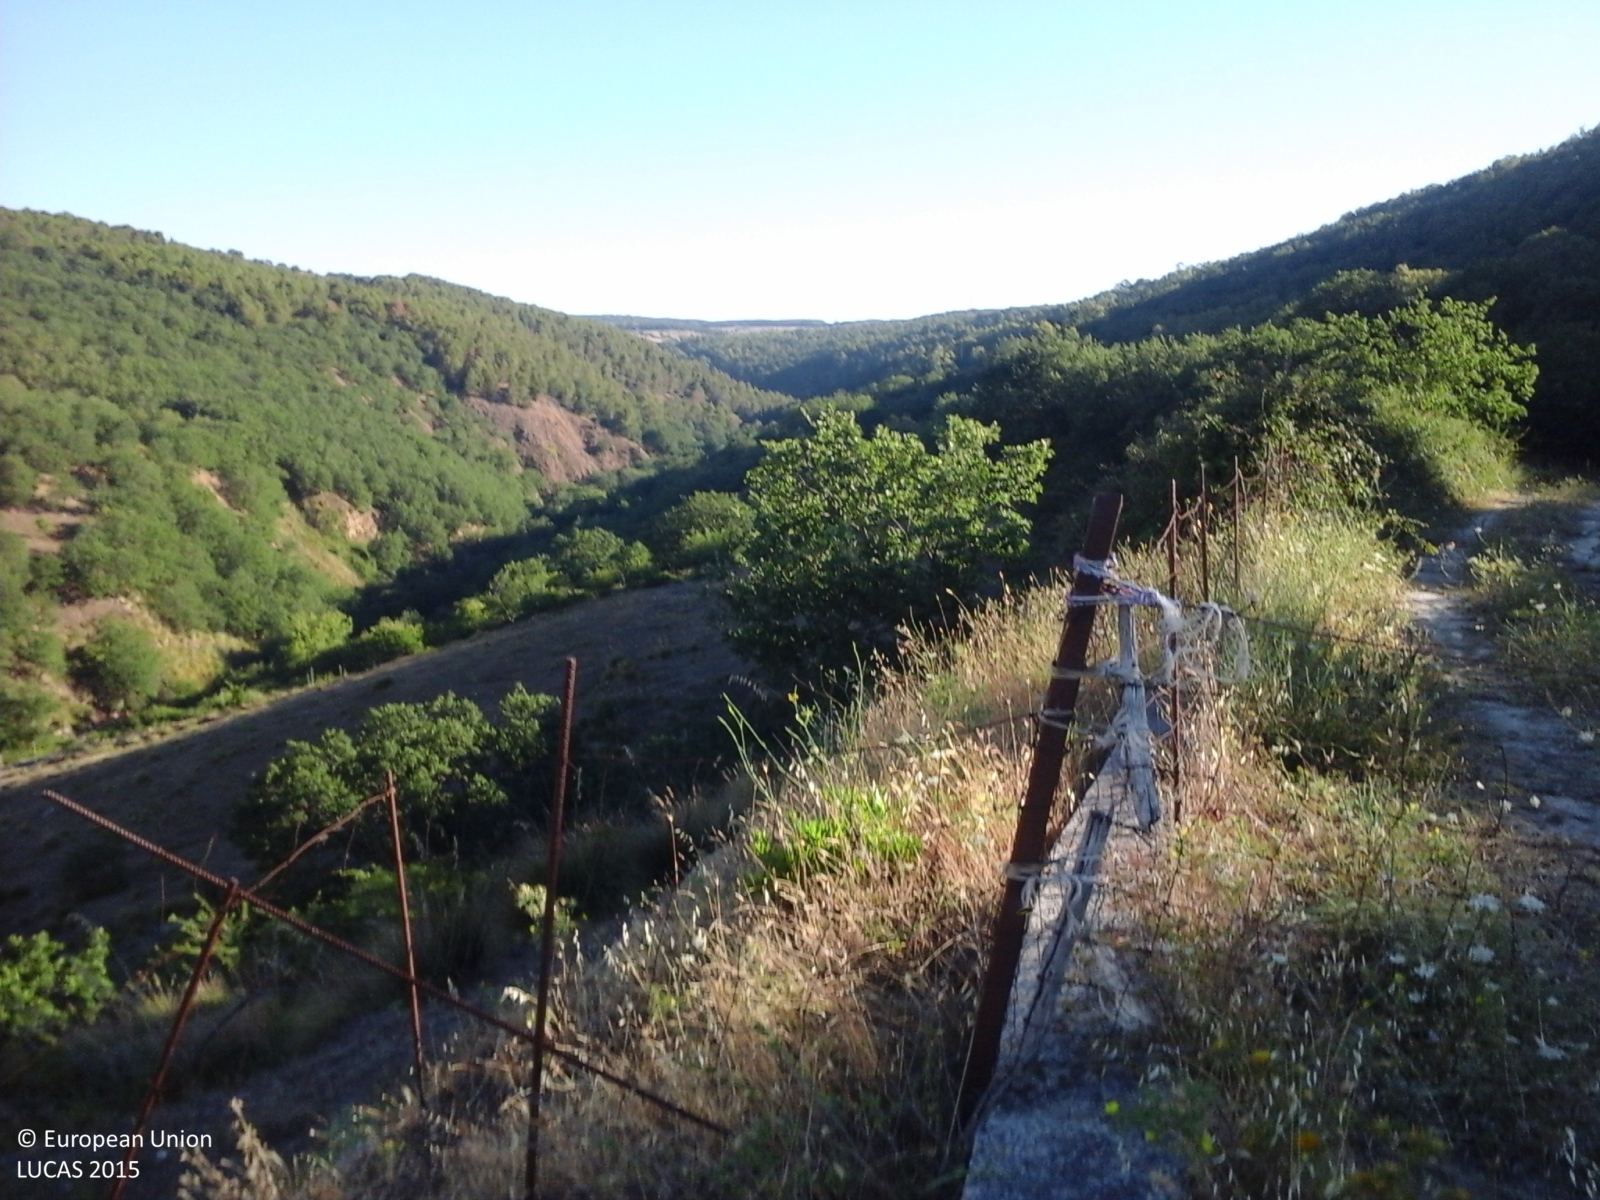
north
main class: Woodland
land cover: Broadleaved woodland
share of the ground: > 75 %
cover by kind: herbaceous plants 75 %, broadleaved forest trees 20 %, consolidated bare surface 5 %
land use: Semi-natural and natural areas not in use
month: July
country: IT
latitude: 37.0801
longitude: 14.8110
